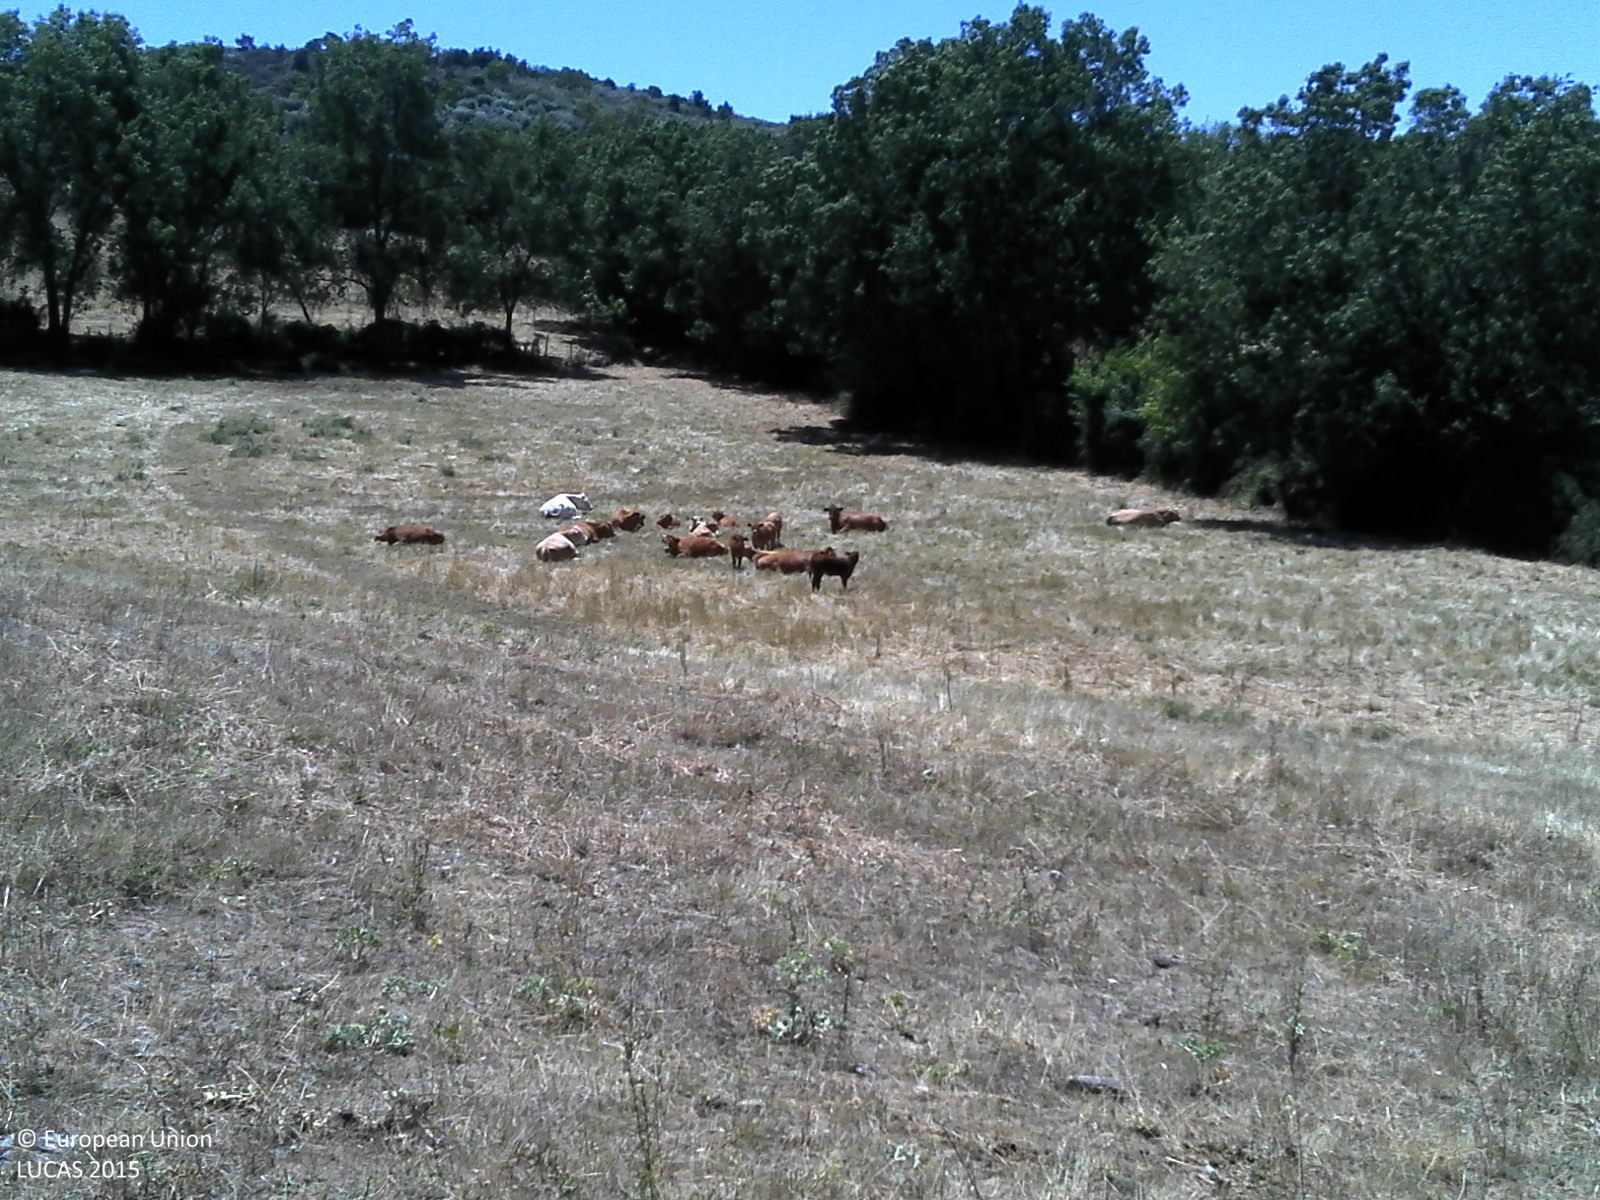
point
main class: Grassland
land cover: Grassland without tree/shrub cover
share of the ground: > 75 %
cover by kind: herbaceous plants 100 %
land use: Agriculture (excluding fallow land and kitchen gardens)
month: June
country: PT
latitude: 41.4787
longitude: -7.0120
